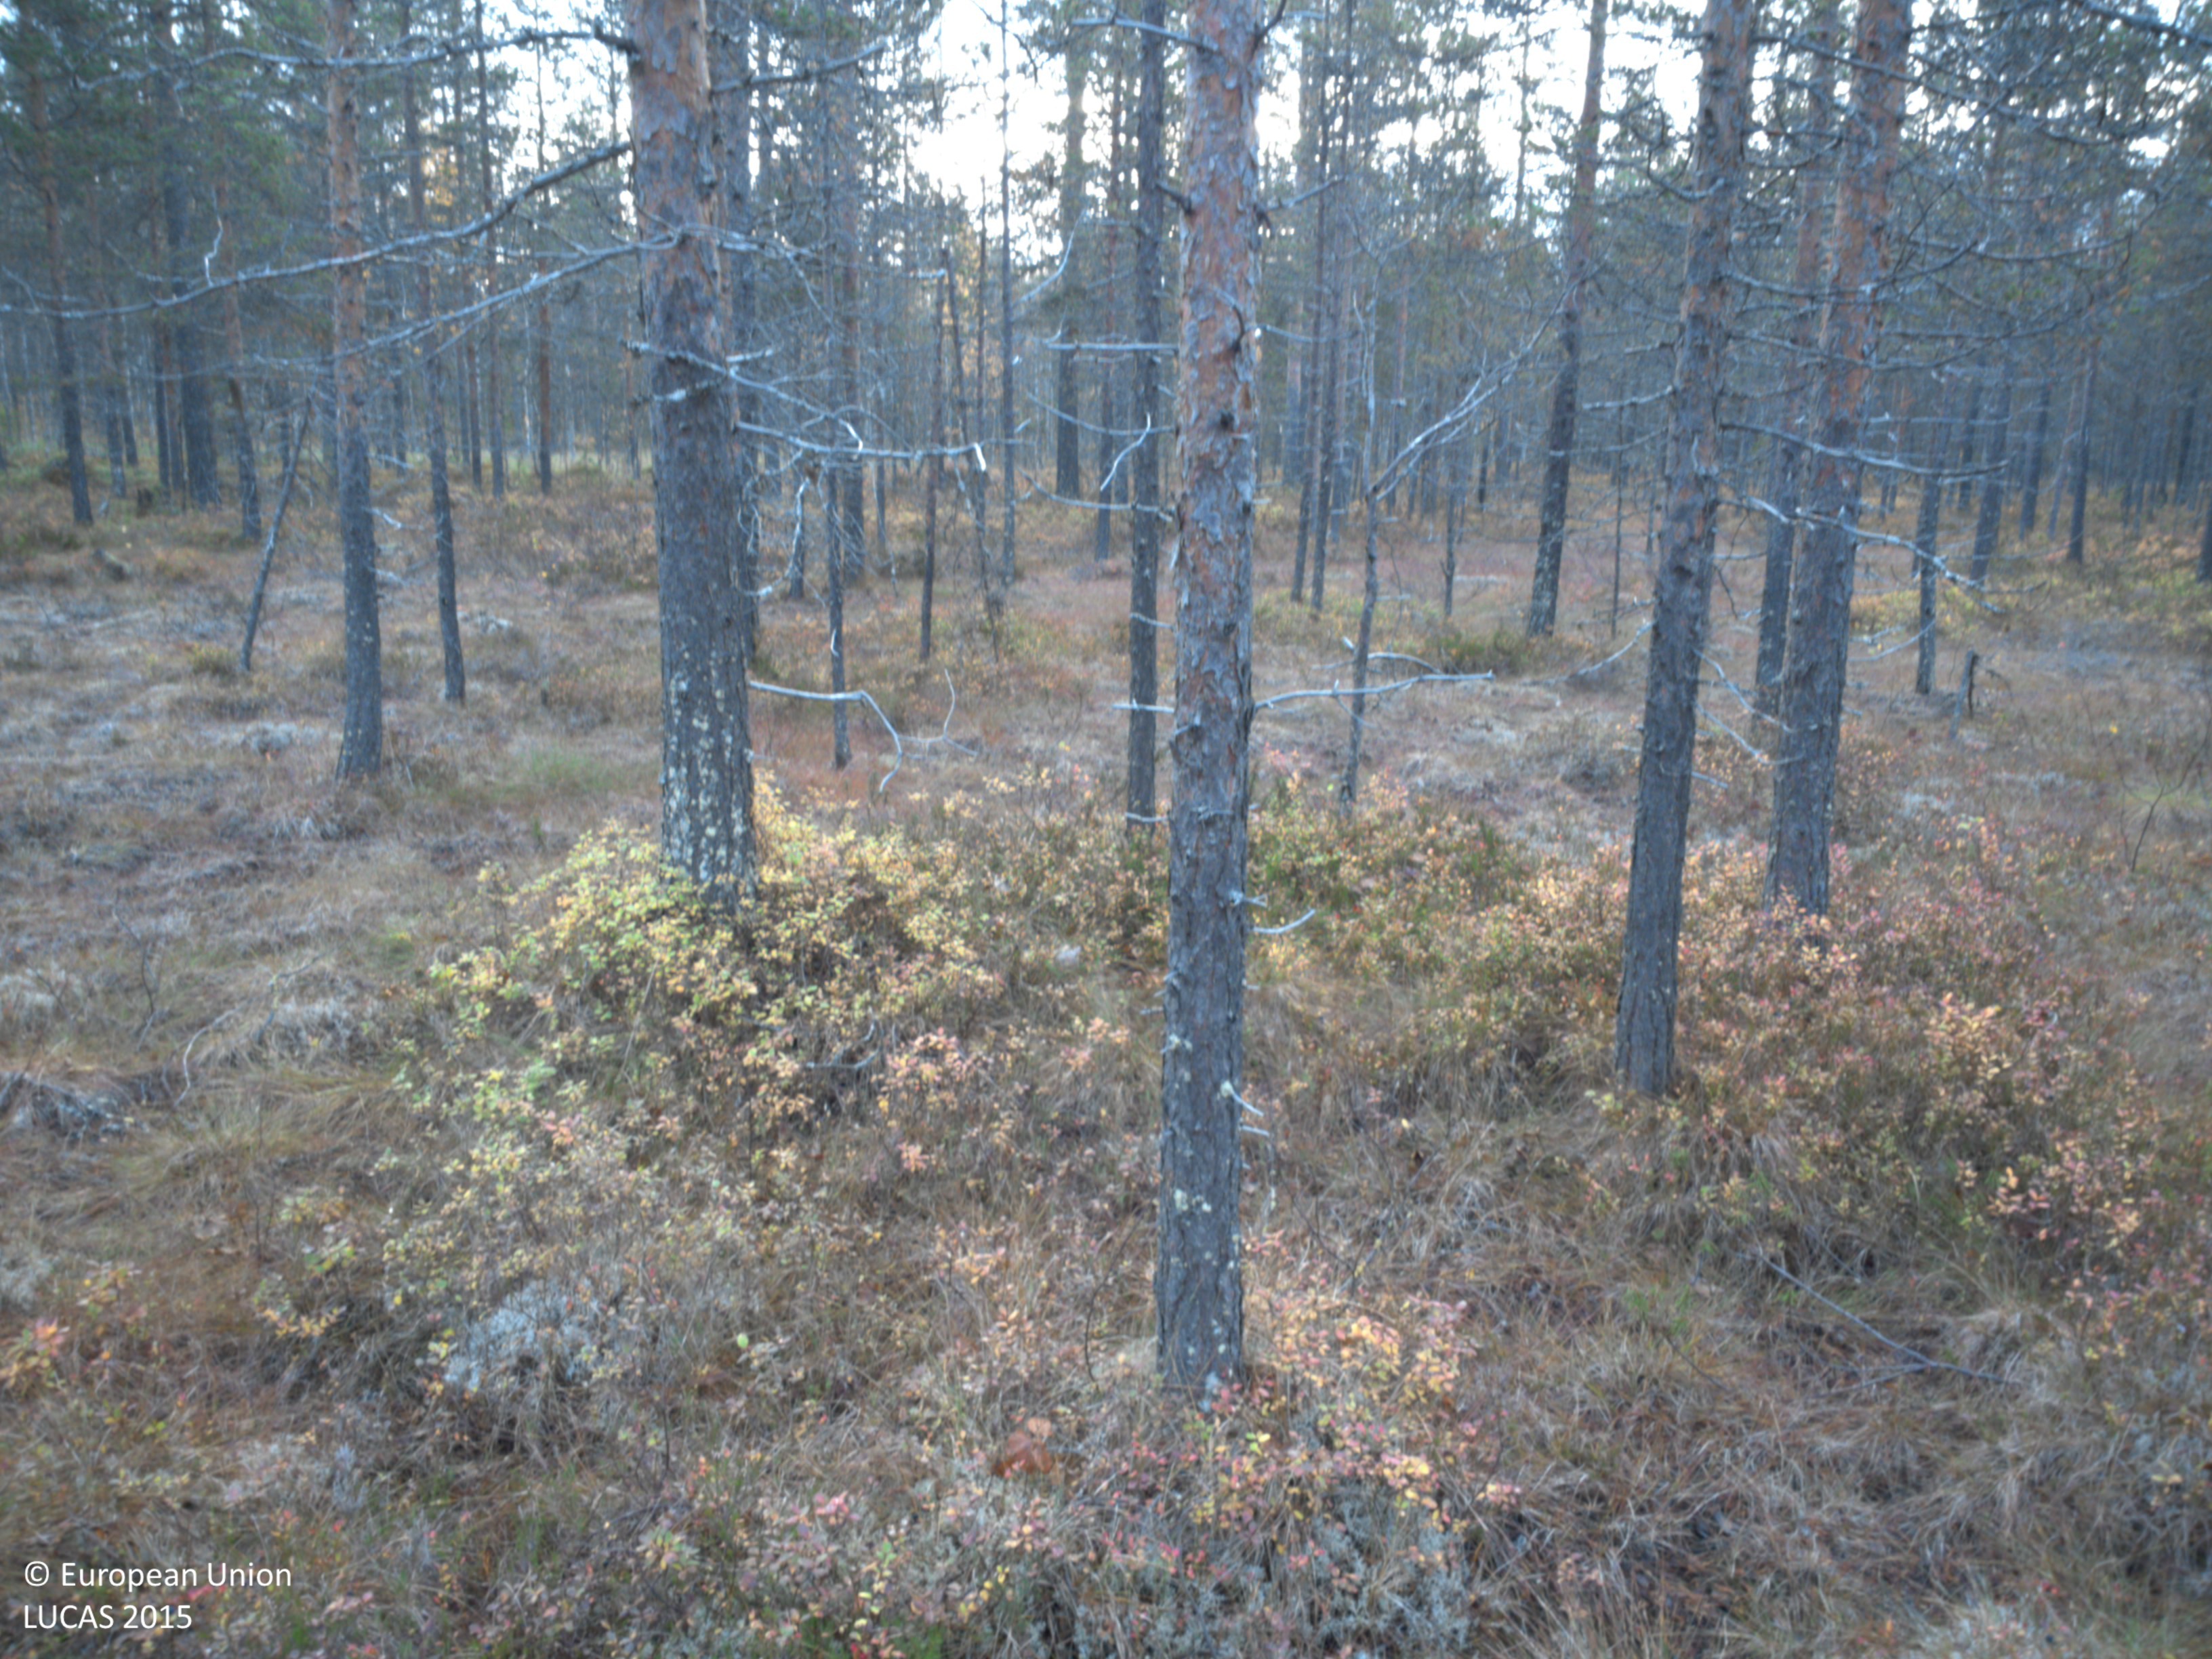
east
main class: Woodland
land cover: Pine dominated coniferous woodland
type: boreal forest
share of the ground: 50 - 75 %
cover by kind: coniferous forest trees 55 %, herbaceous plants 20 %, lichens and mosses 15 %, shrubs 10 %
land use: Forestry
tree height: > 5 m
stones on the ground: < 10 %
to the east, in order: Pine dominated coniferous woodland; Pine dominated mixed woodland; Other mixed woodland; Electric lines; Other mixed woodland; Pine dominated mixed woodland
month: September
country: SE
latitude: 65.0574
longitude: 18.5711
